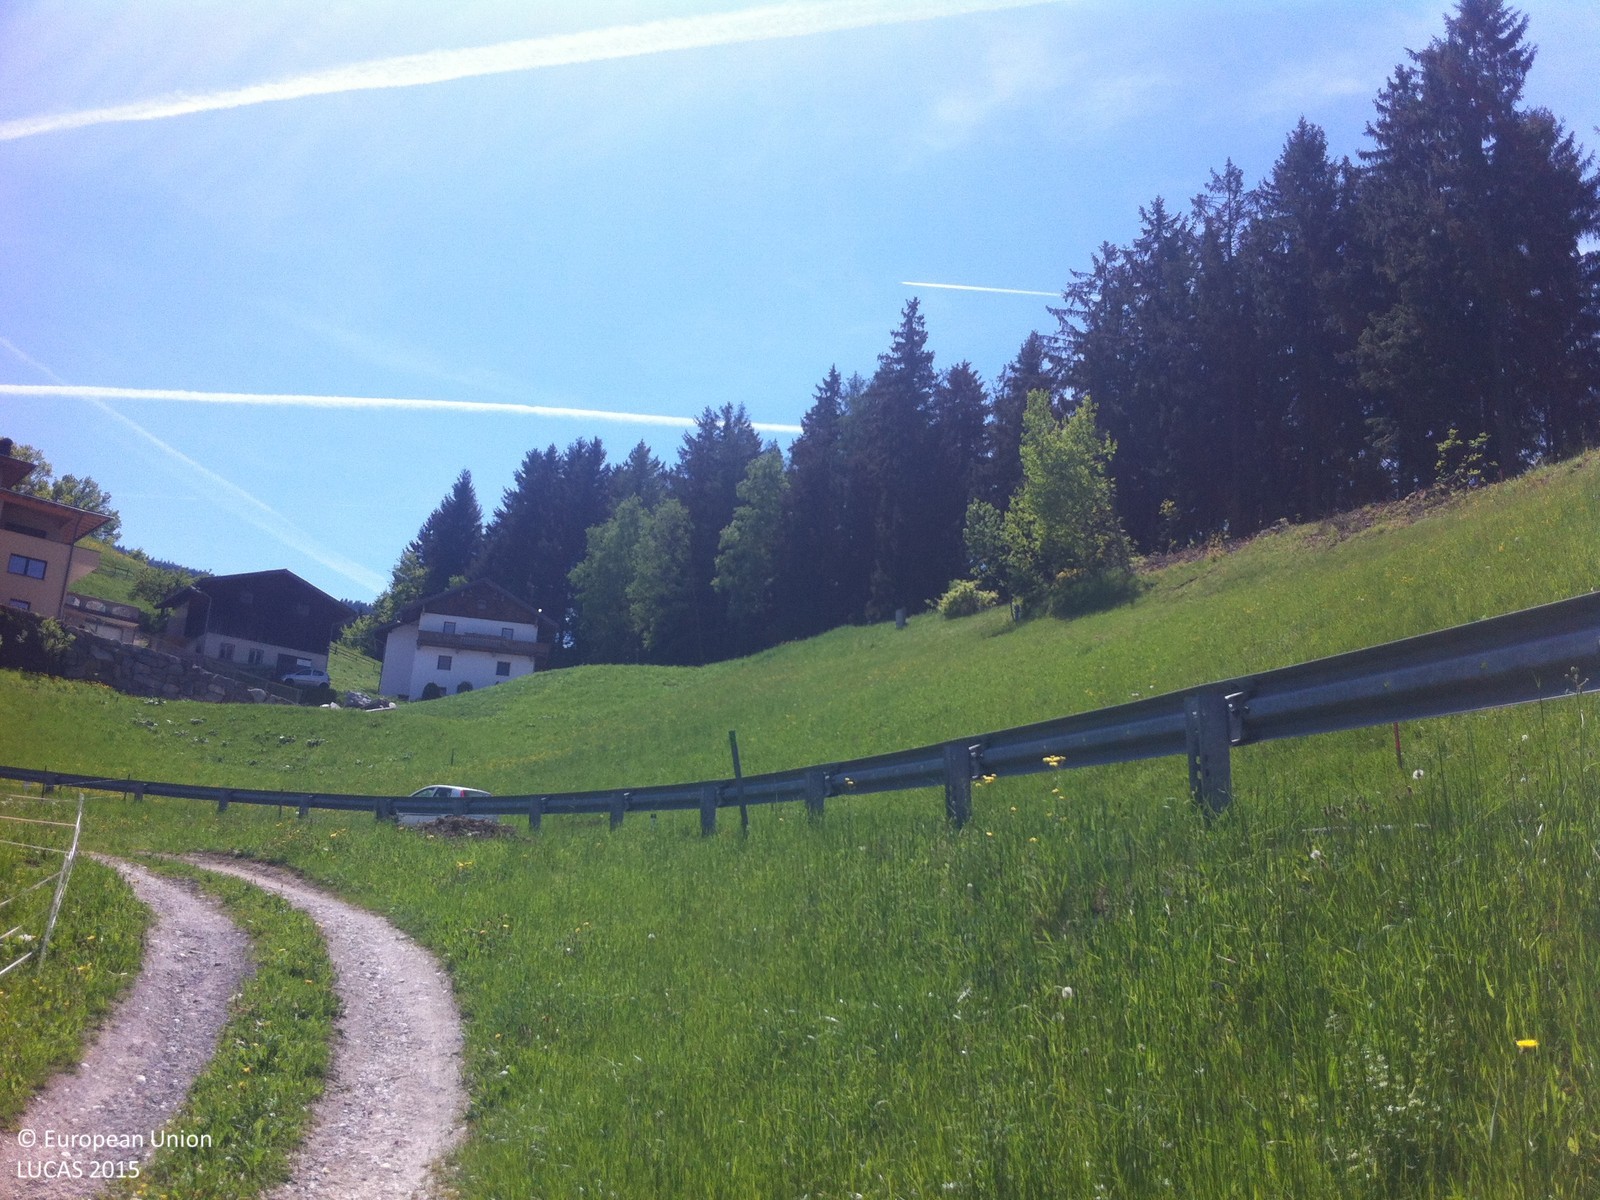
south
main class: Grassland
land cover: Grassland without tree/shrub cover
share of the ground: > 75 %
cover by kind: herbaceous plants 100 %
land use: Agriculture (excluding fallow land and kitchen gardens)
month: May
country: AT
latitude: 47.3106
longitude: 11.6785
